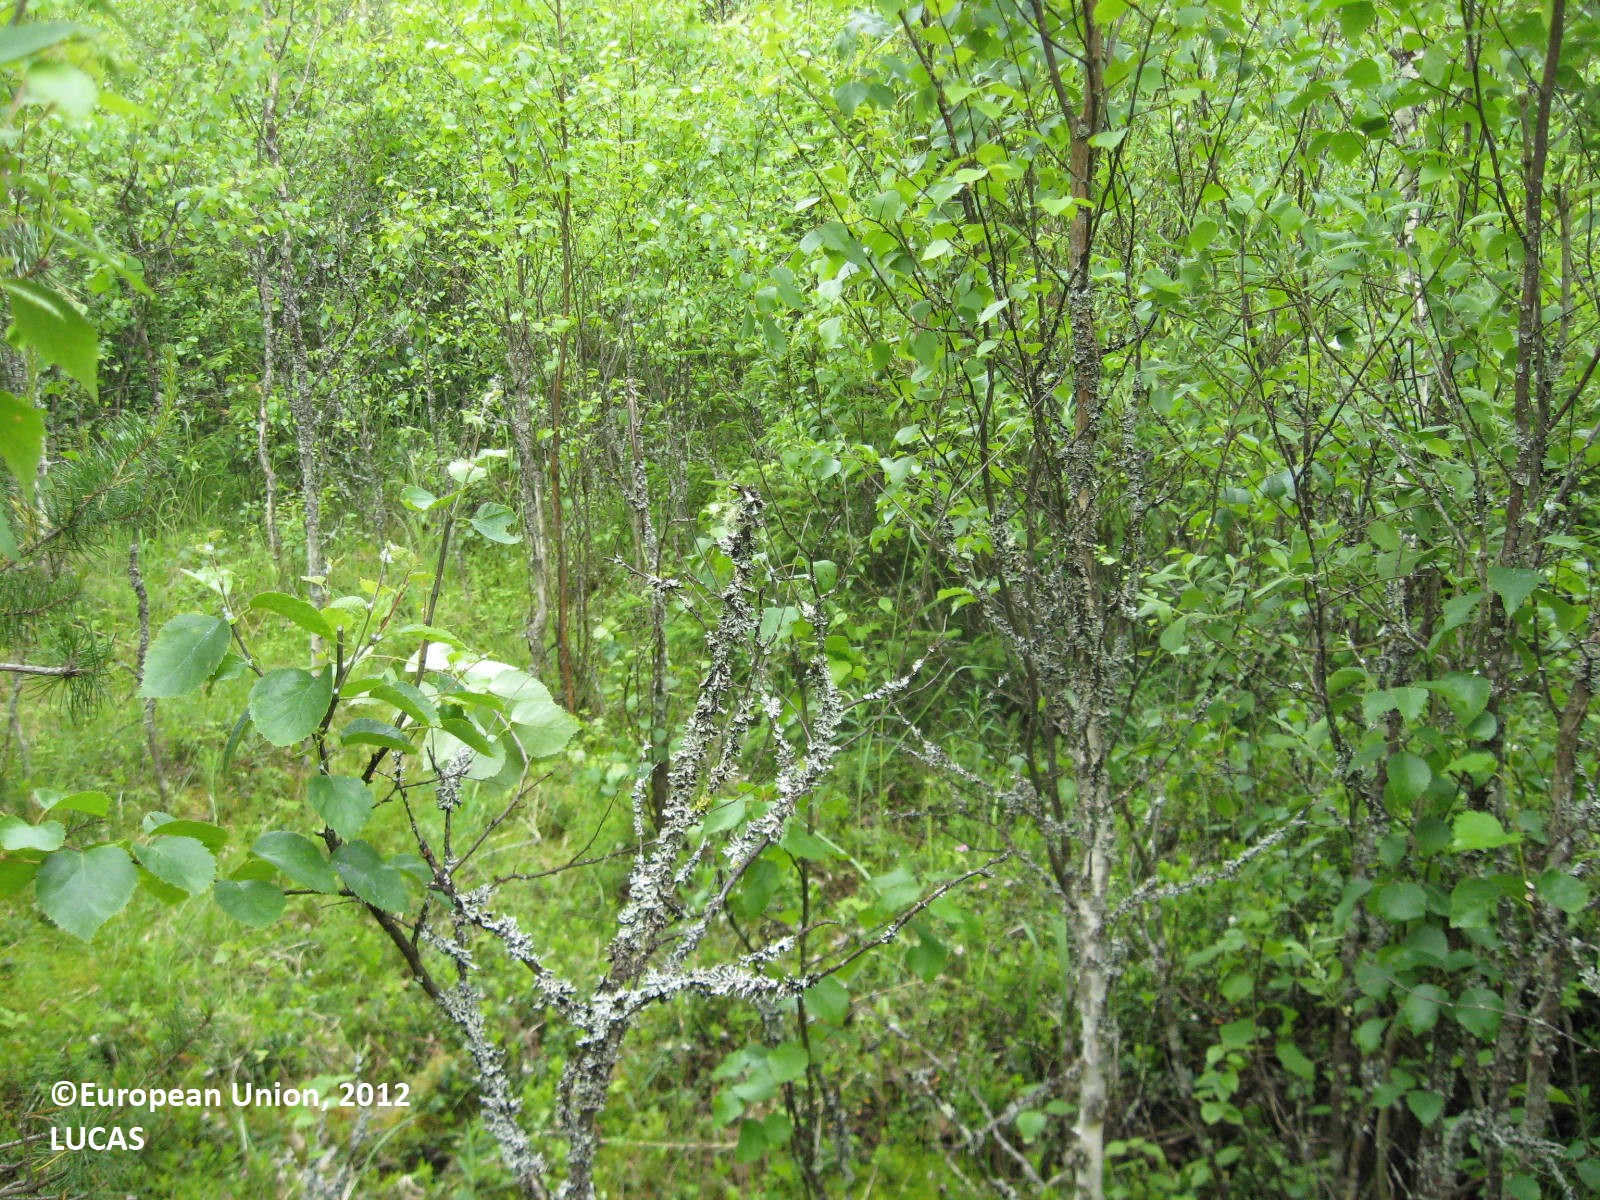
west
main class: Woodland
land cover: Other mixed woodland
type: boreal forest
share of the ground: > 75 %
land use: Forestry
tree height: < 5 m
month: June
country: FI
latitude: 62.8489
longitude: 22.6057
